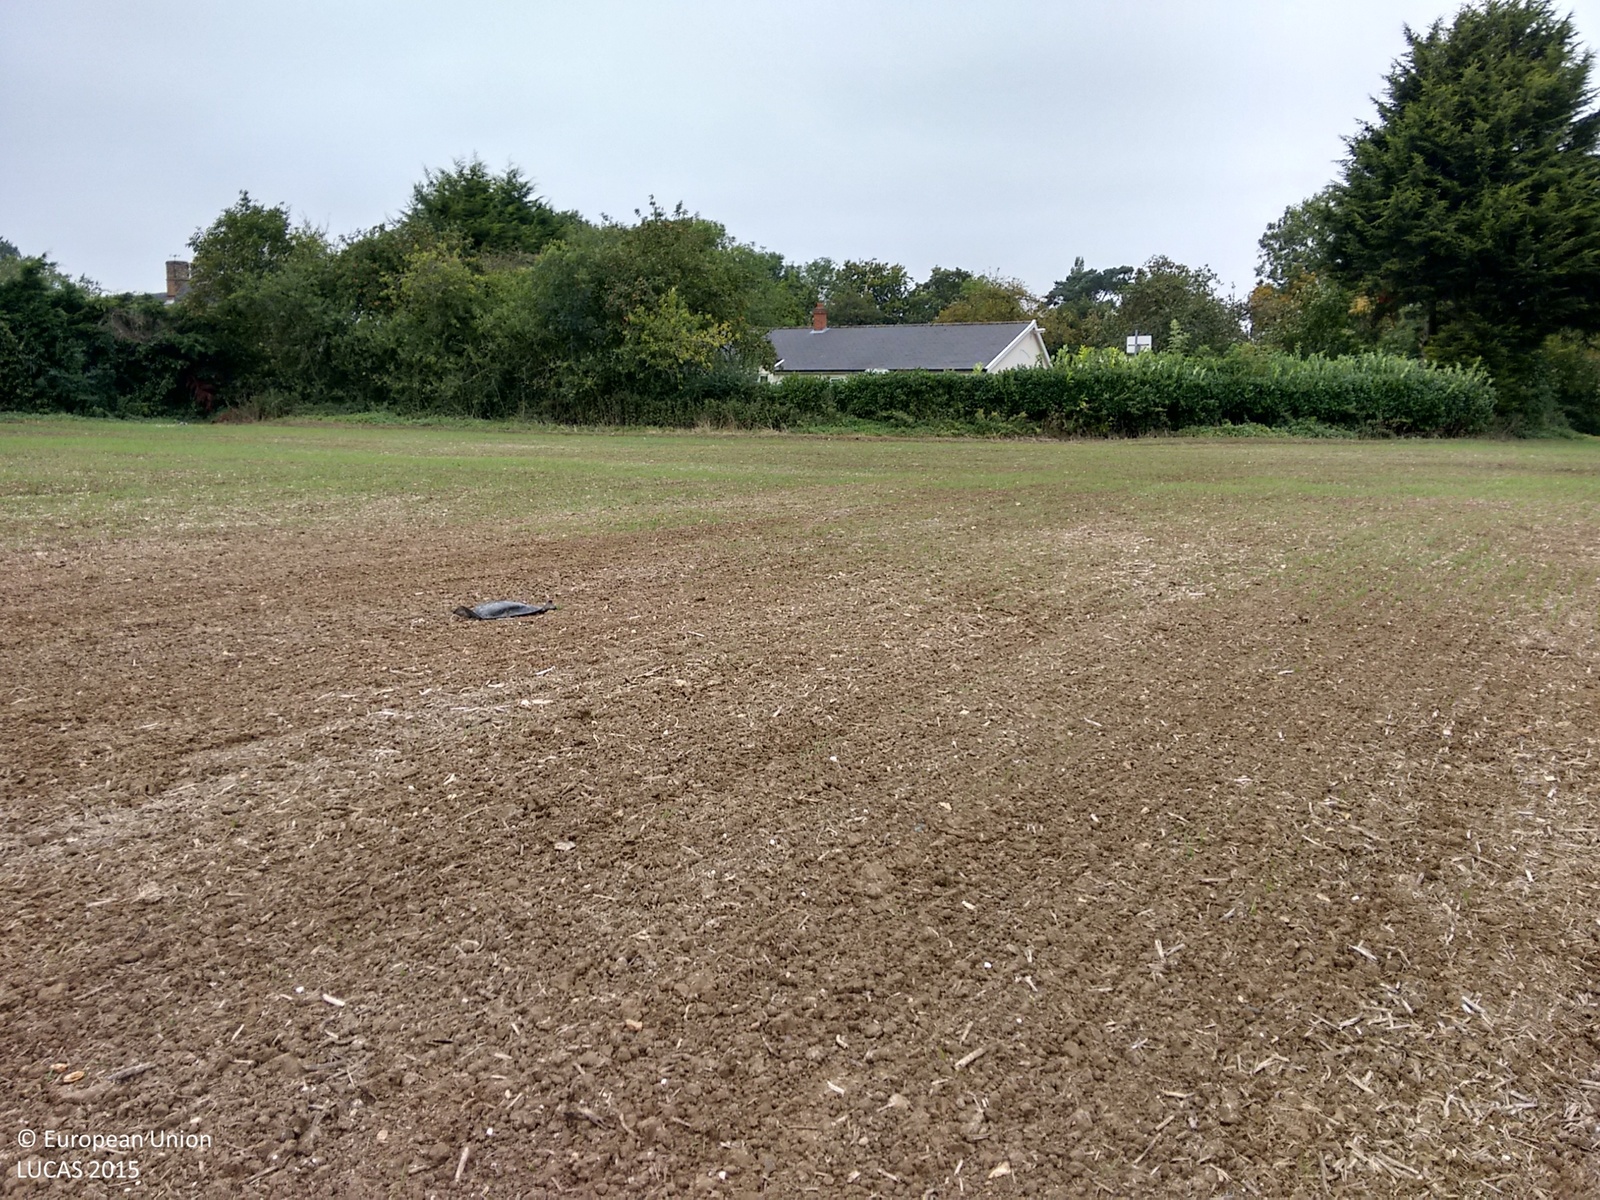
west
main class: Cropland
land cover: Common wheat
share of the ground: < 10 %
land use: Agriculture (excluding fallow land and kitchen gardens)
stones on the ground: 10 - 25 %
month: October
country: GB
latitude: 52.3210
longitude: 0.9537
